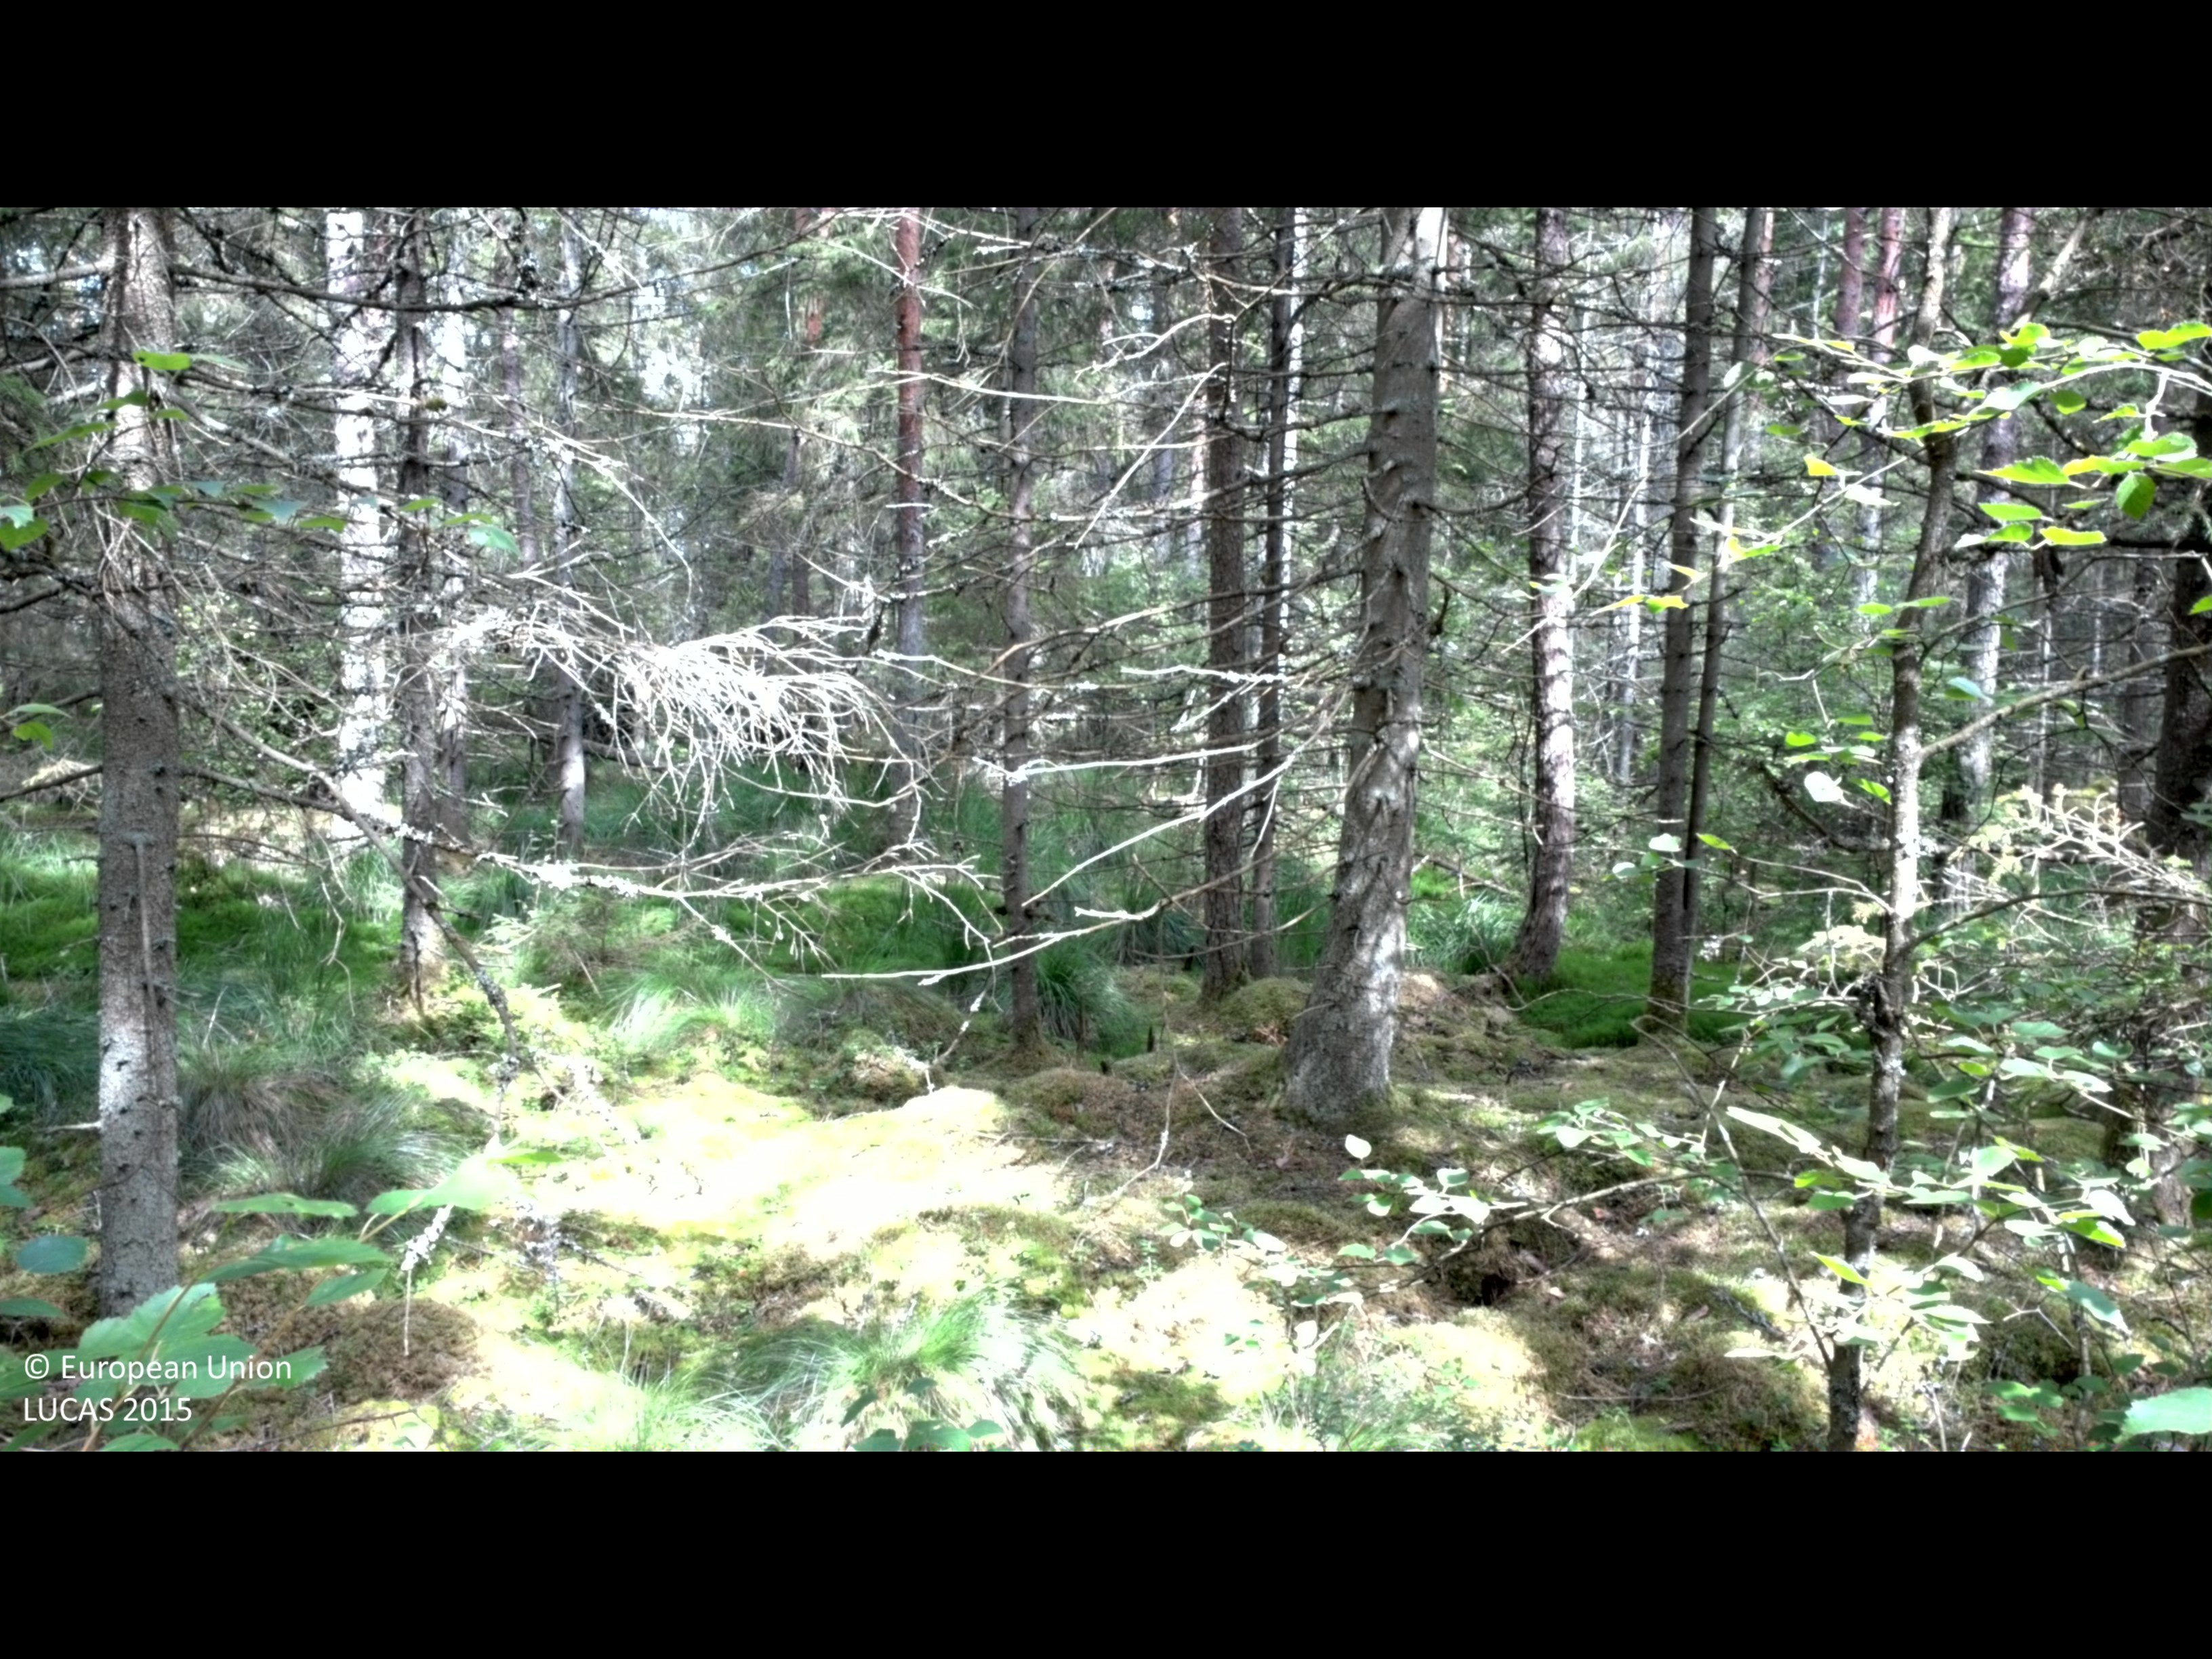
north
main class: Woodland
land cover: Spruce dominated coniferous woodland
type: boreal forest
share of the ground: > 75 %
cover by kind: coniferous forest trees 80 %, herbaceous plants 10 %, broadleaved forest trees 5 %, shrubs 5 %
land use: Forestry
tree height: > 5 m
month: August
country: SE
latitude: 56.7443
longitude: 13.7737
